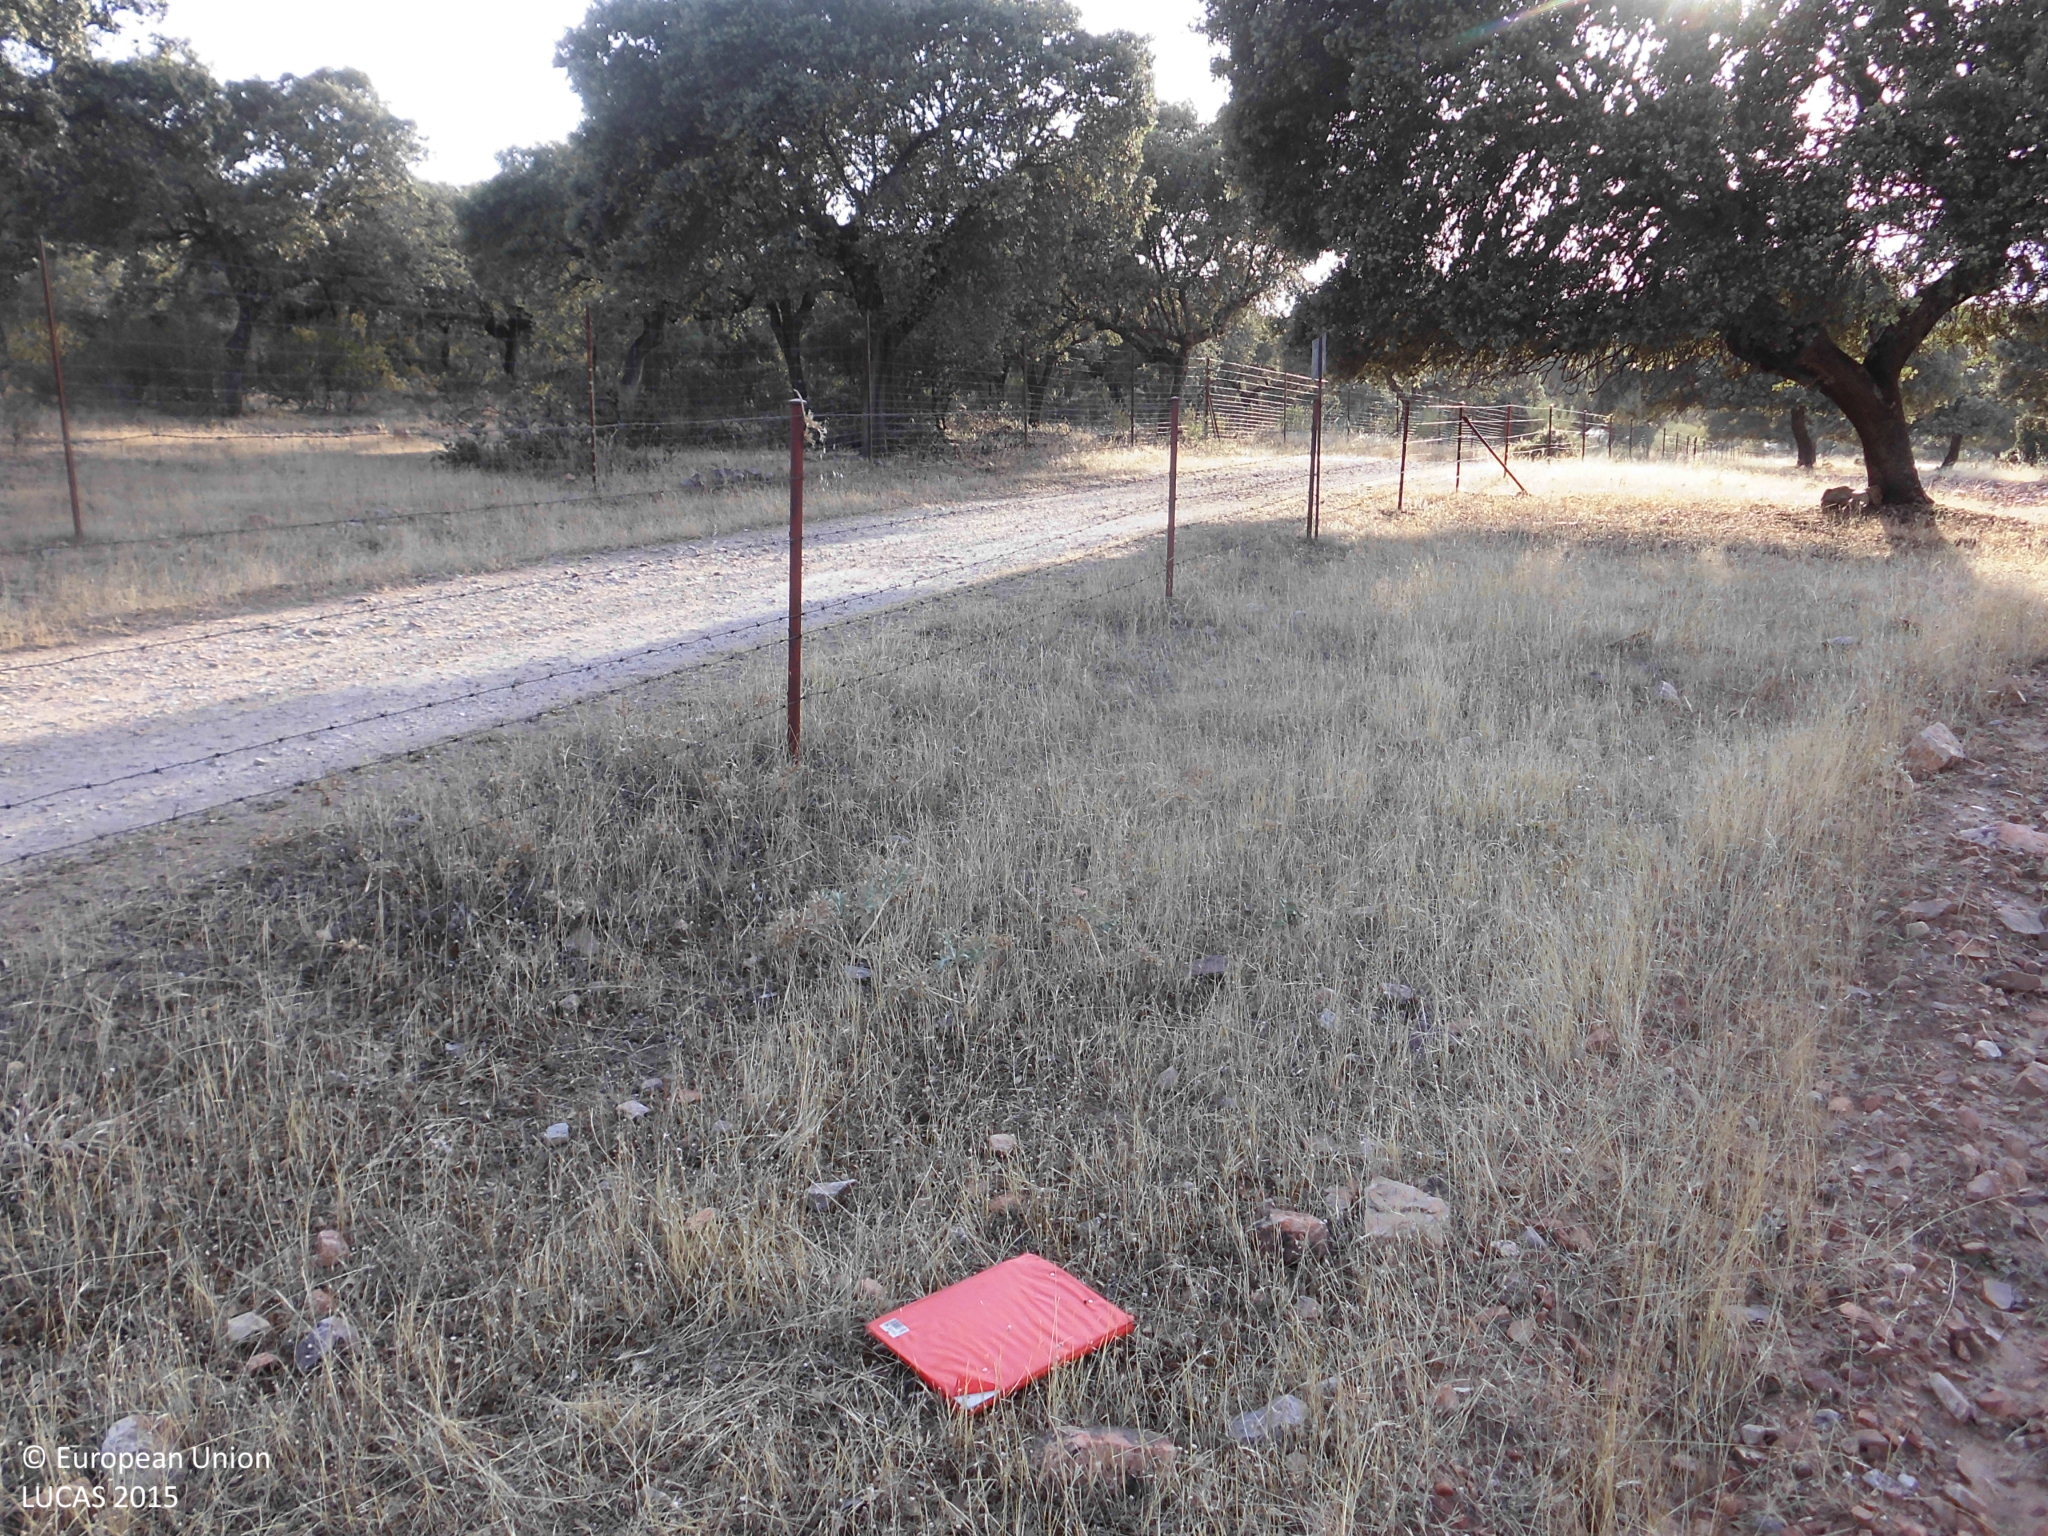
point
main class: Woodland
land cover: Broadleaved woodland
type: broadleaved evergreen forest
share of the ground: 10 - 25 %
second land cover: Grassland without tree/shrub cover
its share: > 75 %
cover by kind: herbaceous plants 65 %, broadleaved forest trees 25 %, unconsolidated bare surface 10 %
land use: Forestry
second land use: Agriculture (excluding fallow land and kitchen gardens)
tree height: > 5 m
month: July
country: ES
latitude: 39.8111
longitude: -5.6540
